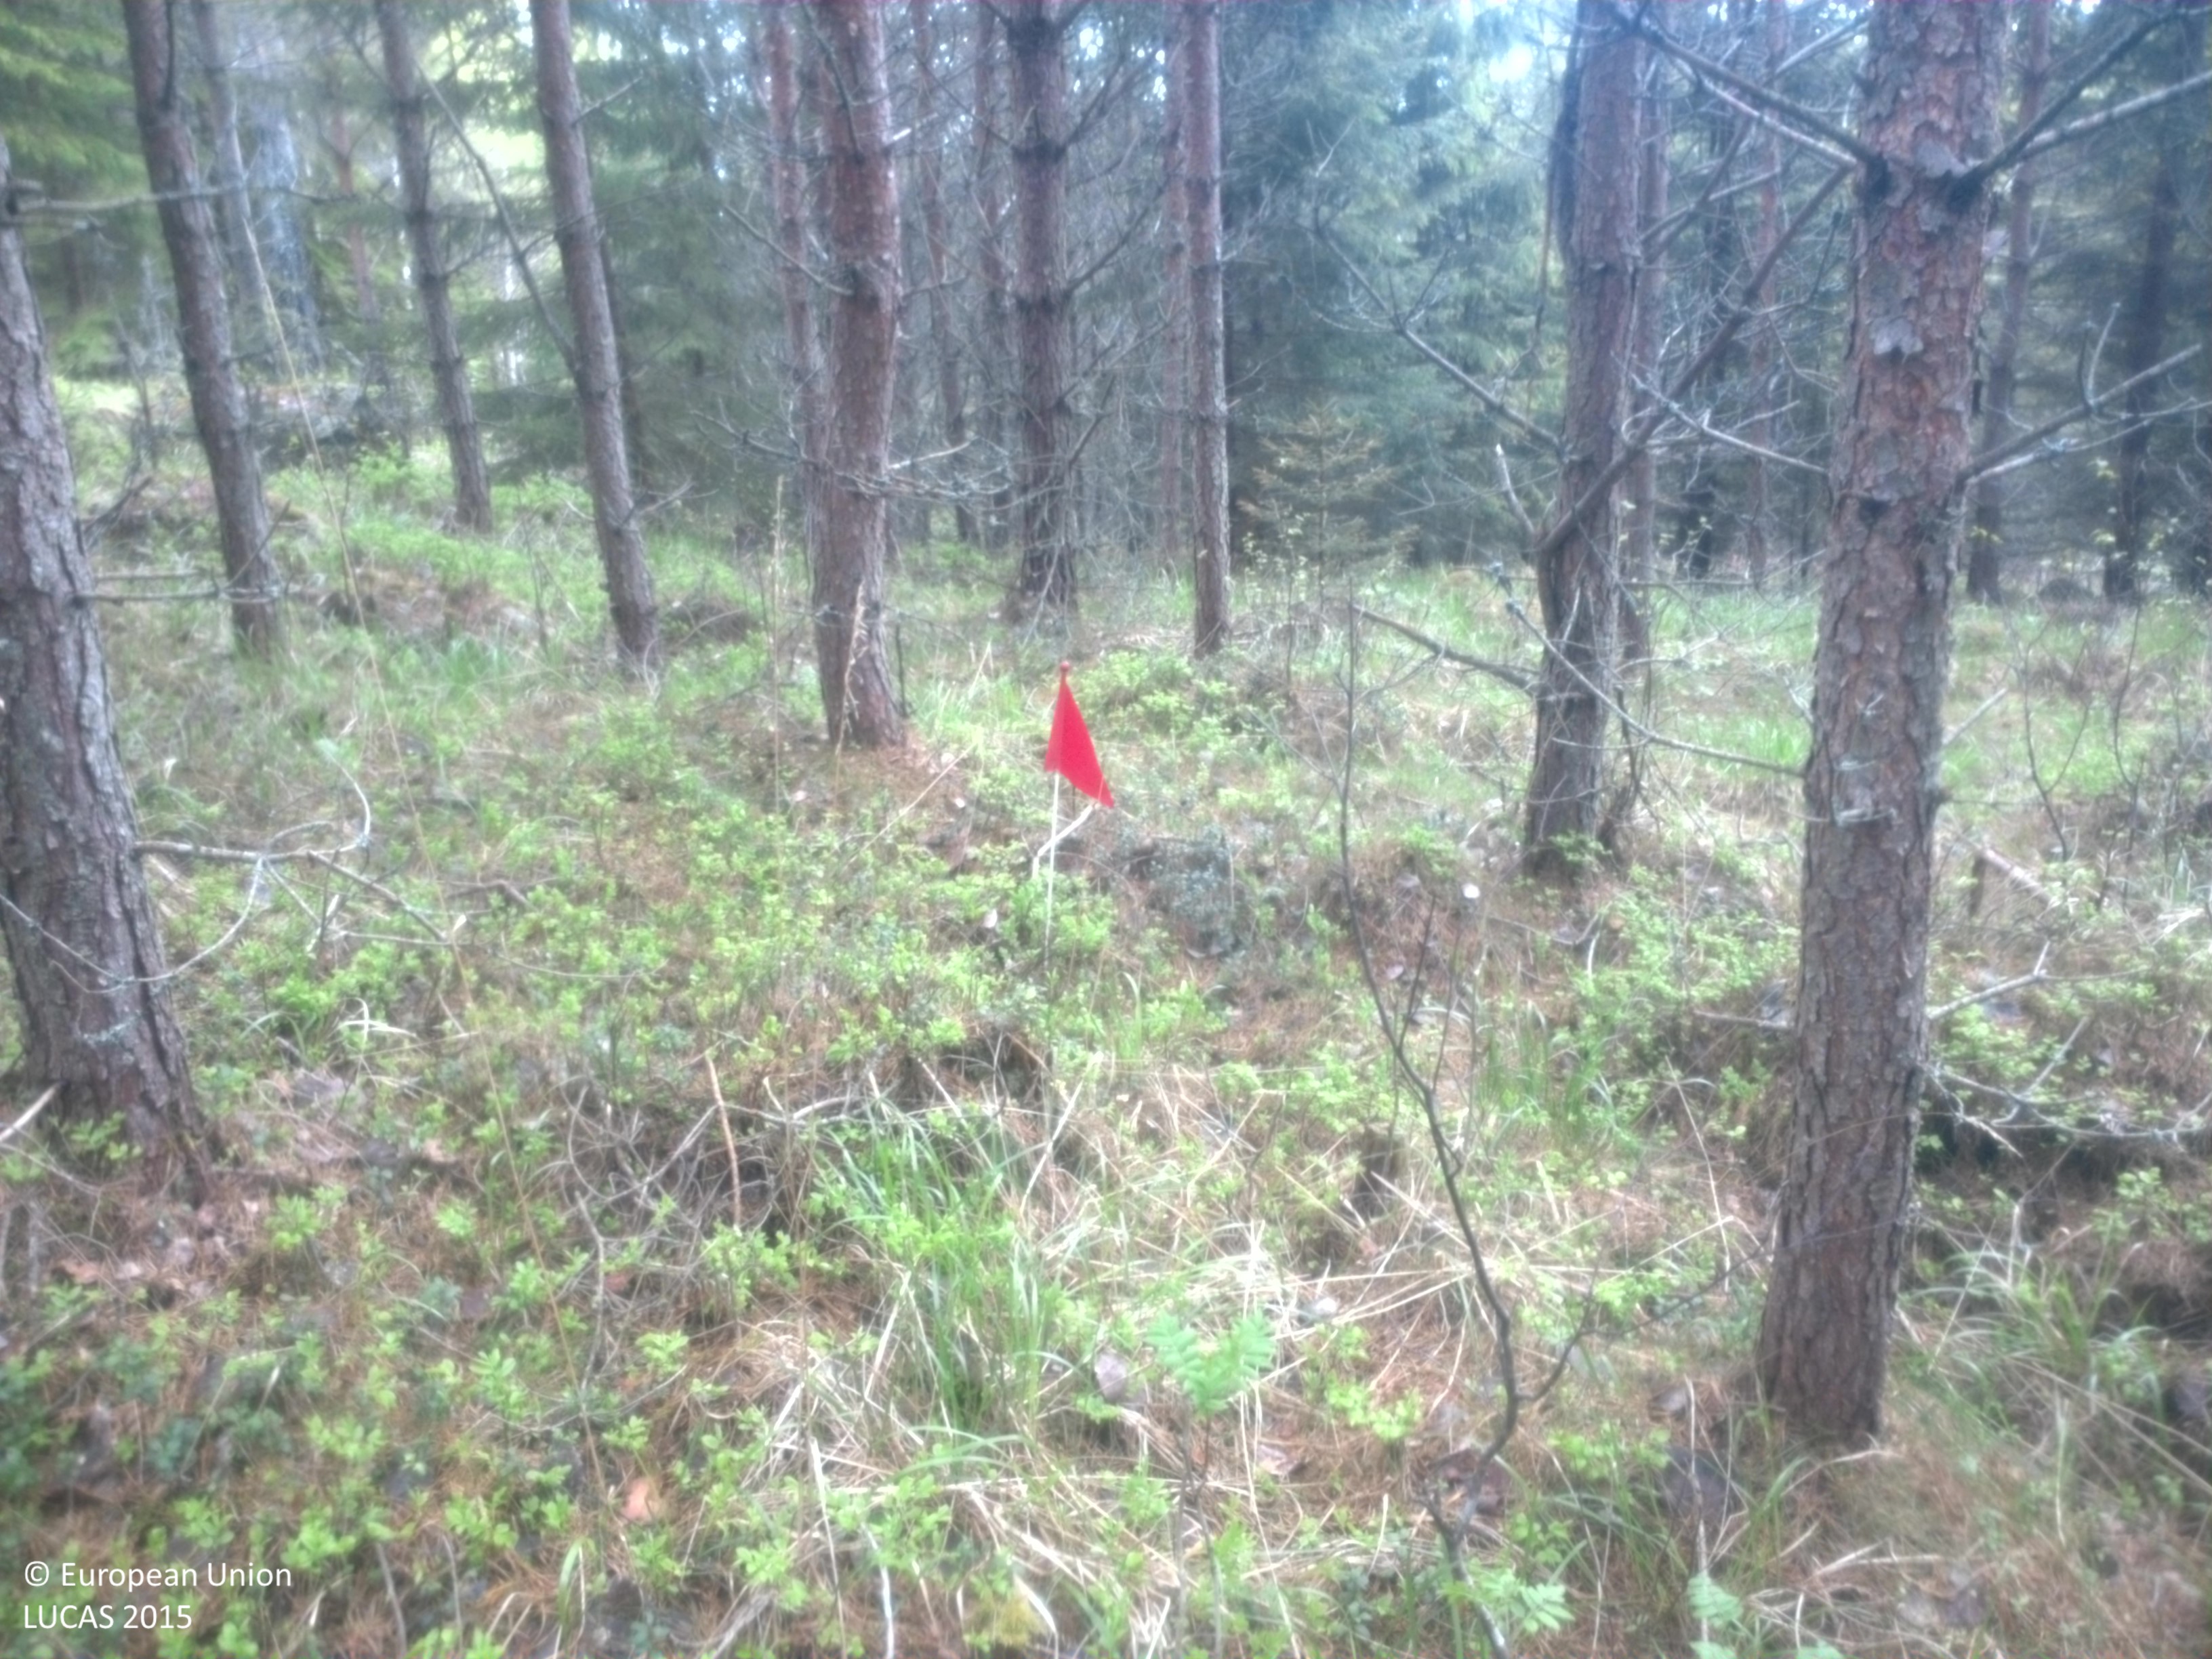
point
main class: Woodland
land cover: Pine dominated coniferous woodland
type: boreal forest
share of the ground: 25 - 50 %
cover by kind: coniferous forest trees 45 %, shrubs 30 %, herbaceous plants 10 %, lichens and mosses 10 %, broadleaved forest trees 5 %
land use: Forestry
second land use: Amenities, museums, leisure
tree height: > 5 m
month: May
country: SE
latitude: 59.5843
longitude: 12.3844
